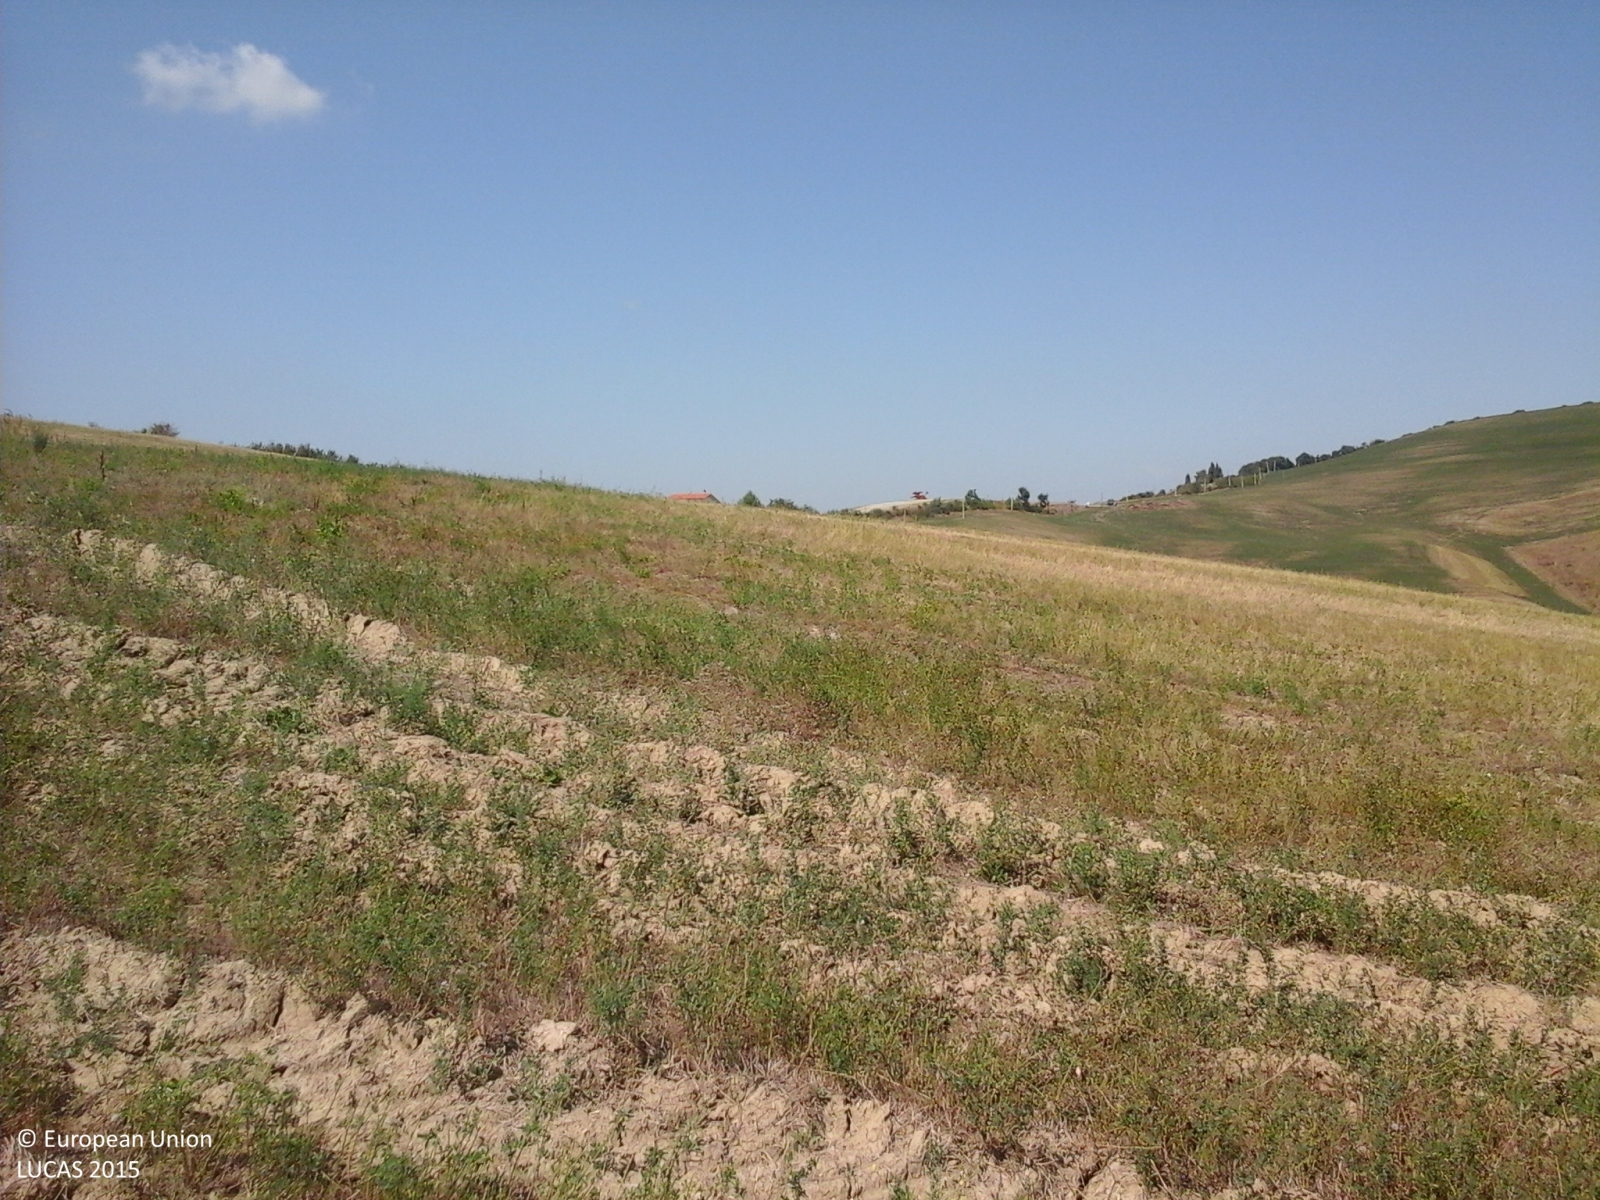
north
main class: Cropland
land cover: Lucerne
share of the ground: > 75 %
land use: Agriculture (excluding fallow land and kitchen gardens)
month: August
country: IT
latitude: 43.7749
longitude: 12.6647
